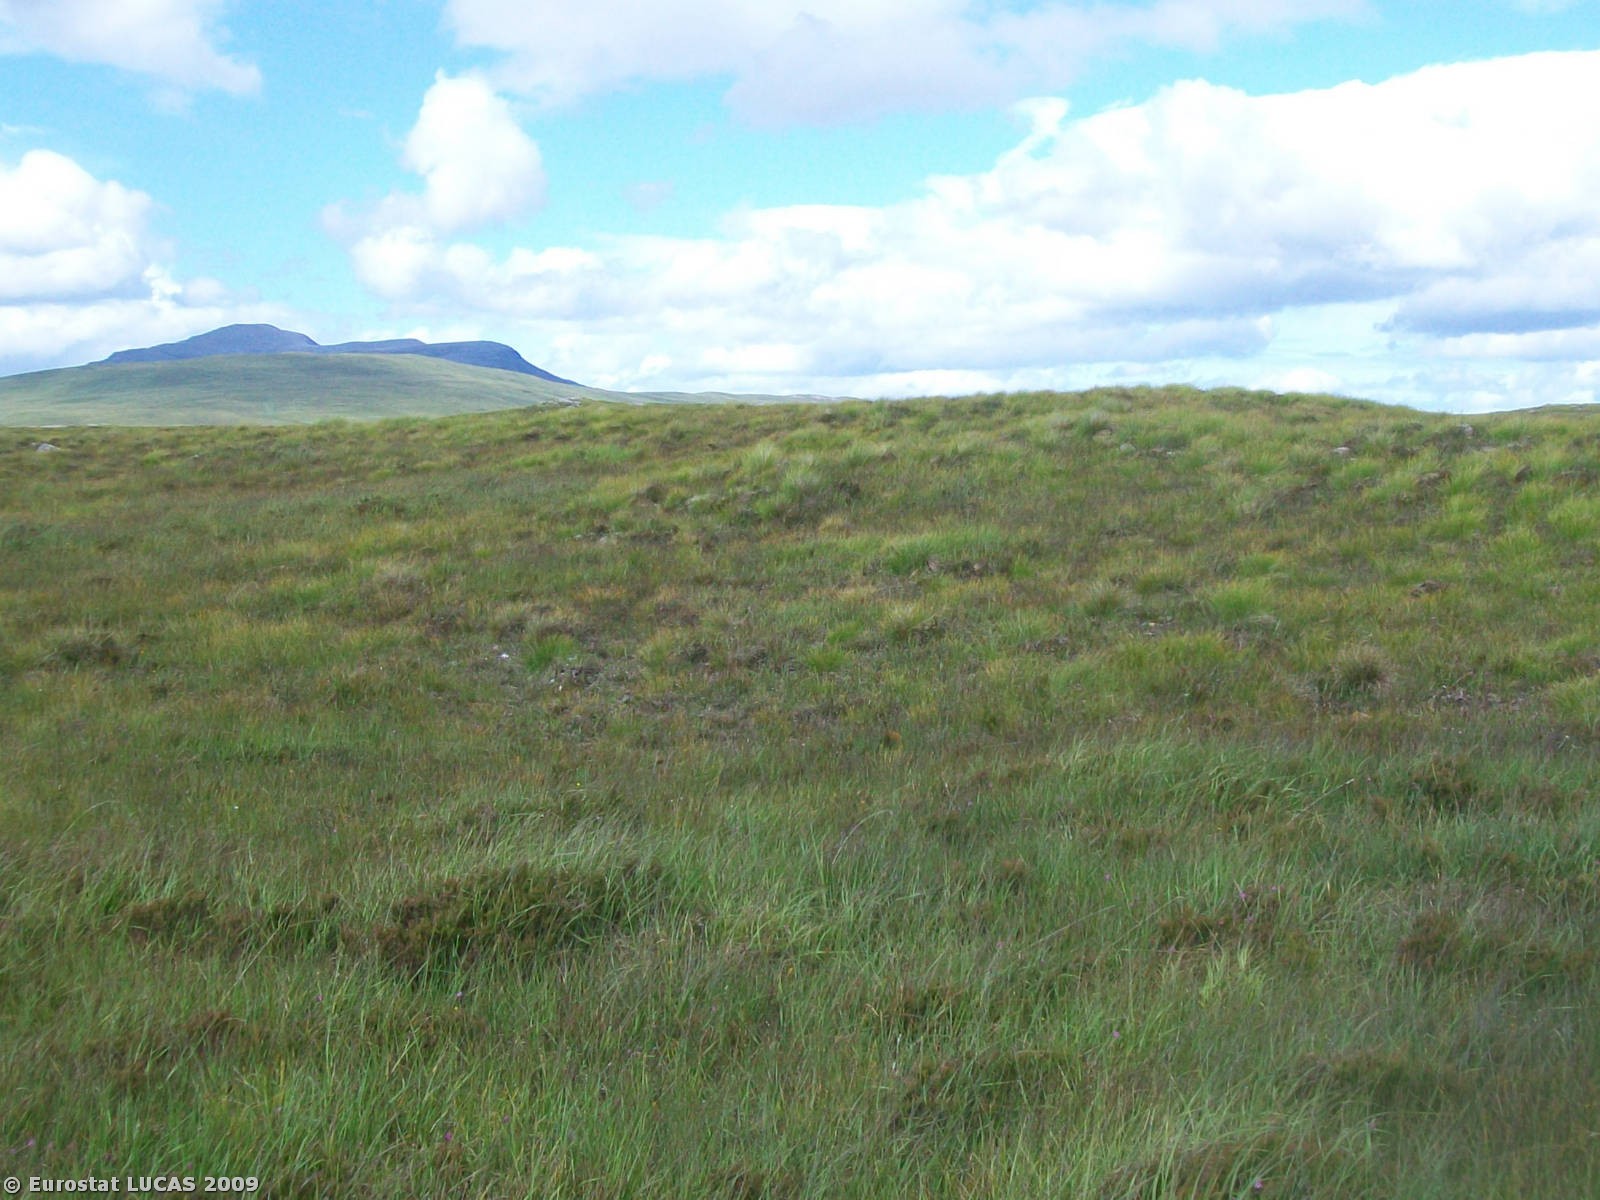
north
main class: Shrubland
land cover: Shrubland without tree cover
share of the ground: > 75 %
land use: Fallow land
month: July
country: GB
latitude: 58.3200
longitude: -4.5471
